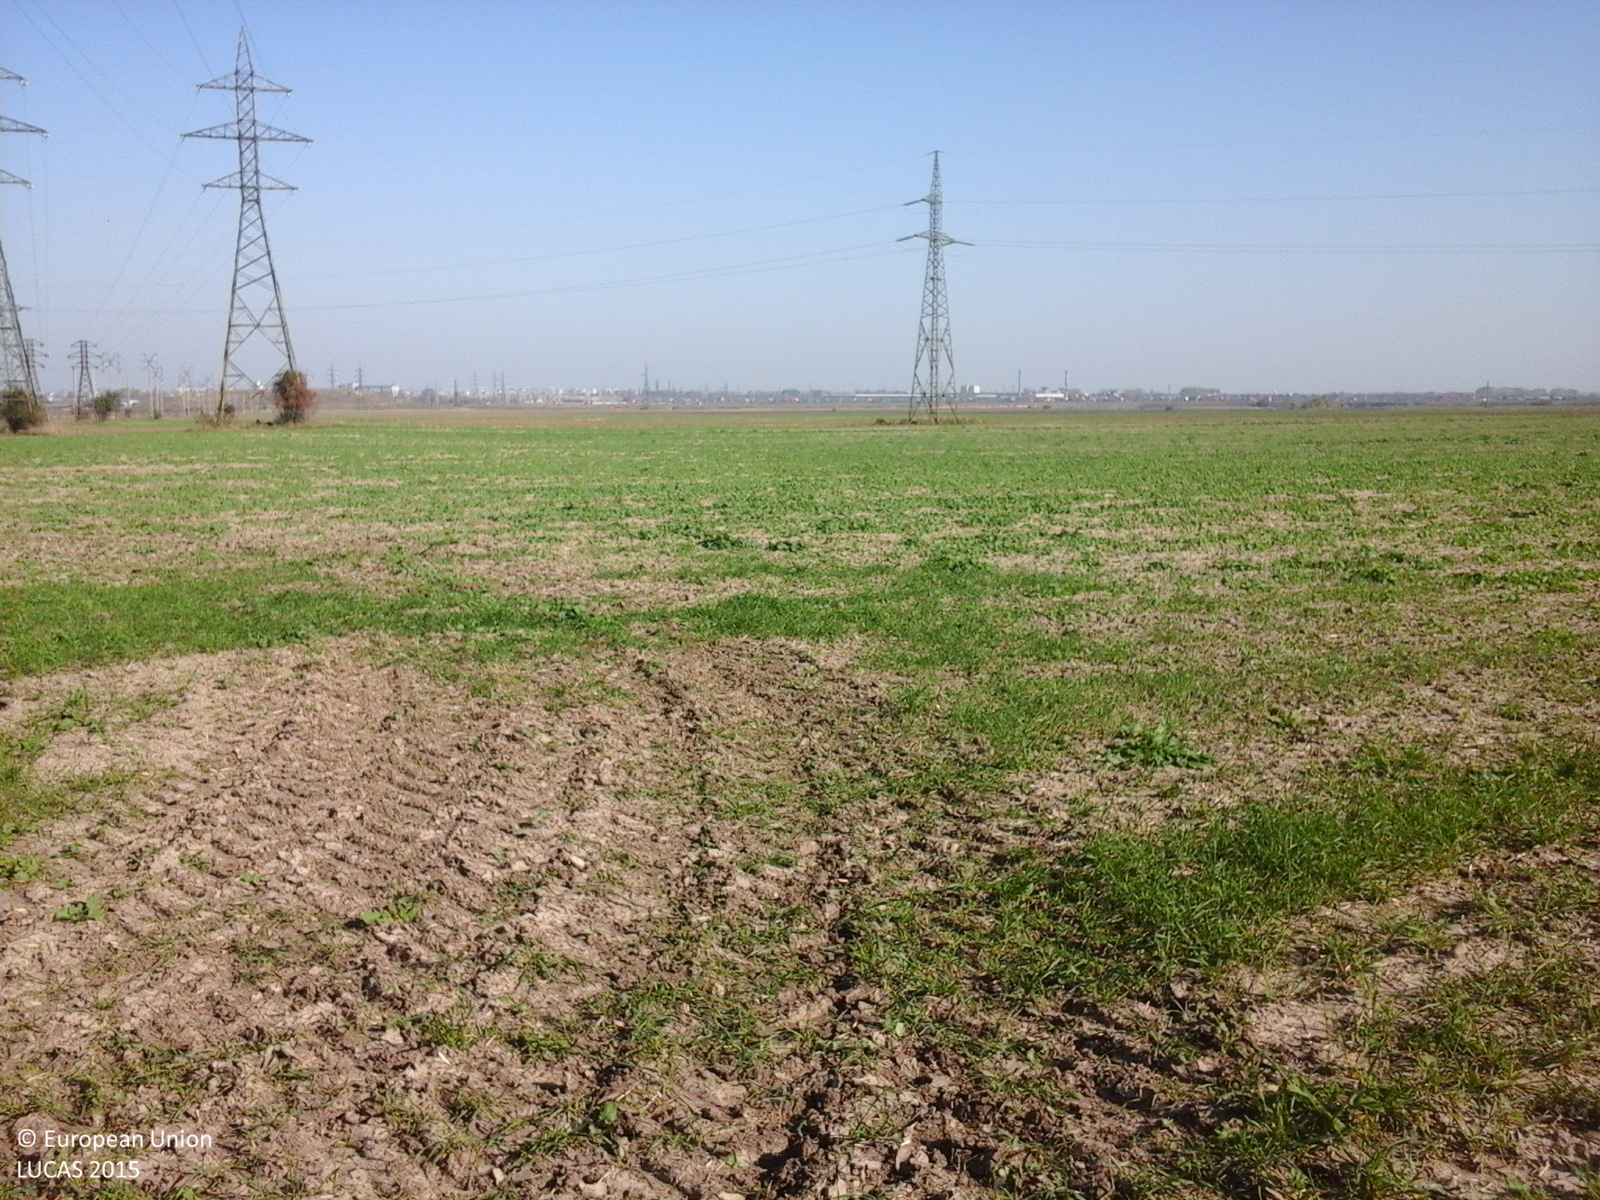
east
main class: Cropland
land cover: Rape and turnip rape
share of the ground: 50 - 75 %
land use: Agriculture (excluding fallow land and kitchen gardens)
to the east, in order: Rape and turnip rape; Electric lines; Rape and turnip rape; Electric lines; Rape and turnip rape; Other bare soil
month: October
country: RO
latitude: 45.6739
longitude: 27.1280
